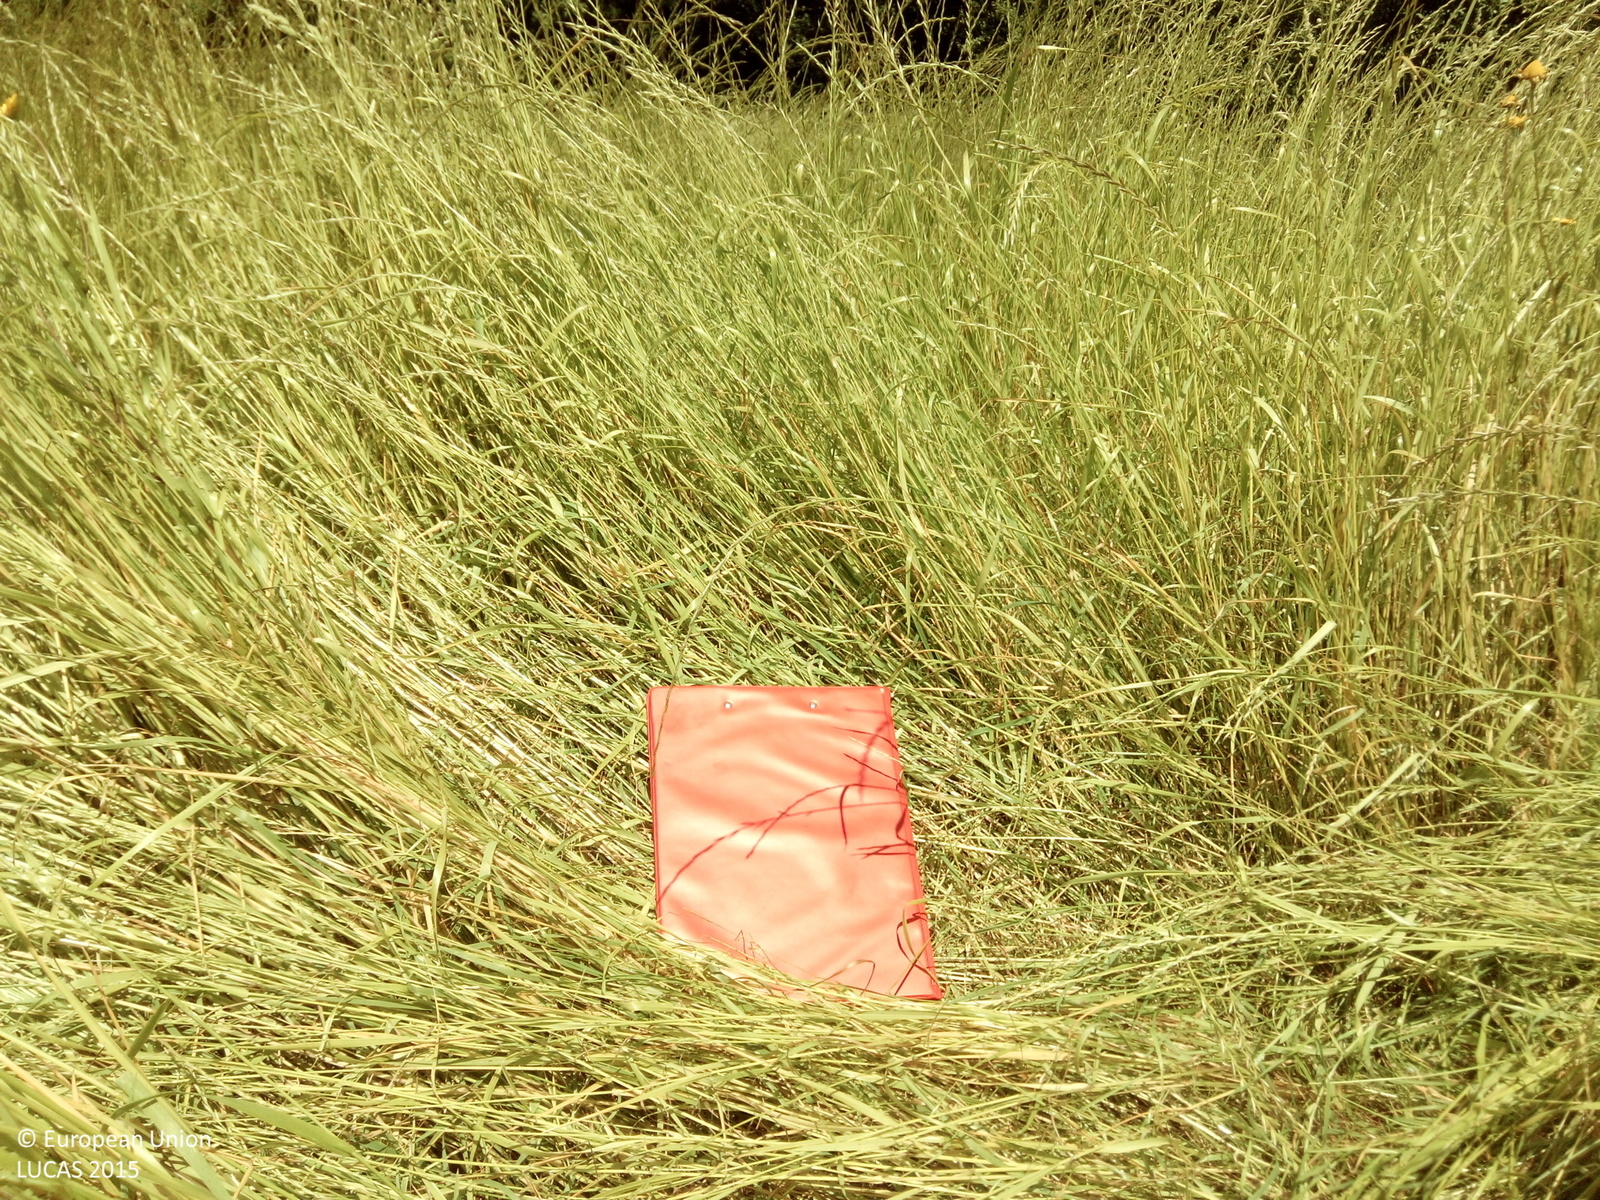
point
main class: Cropland
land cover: Temporary grasslands
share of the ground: > 75 %
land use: Agriculture (excluding fallow land and kitchen gardens)
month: May
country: ES
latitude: 42.7716
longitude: -8.4448
